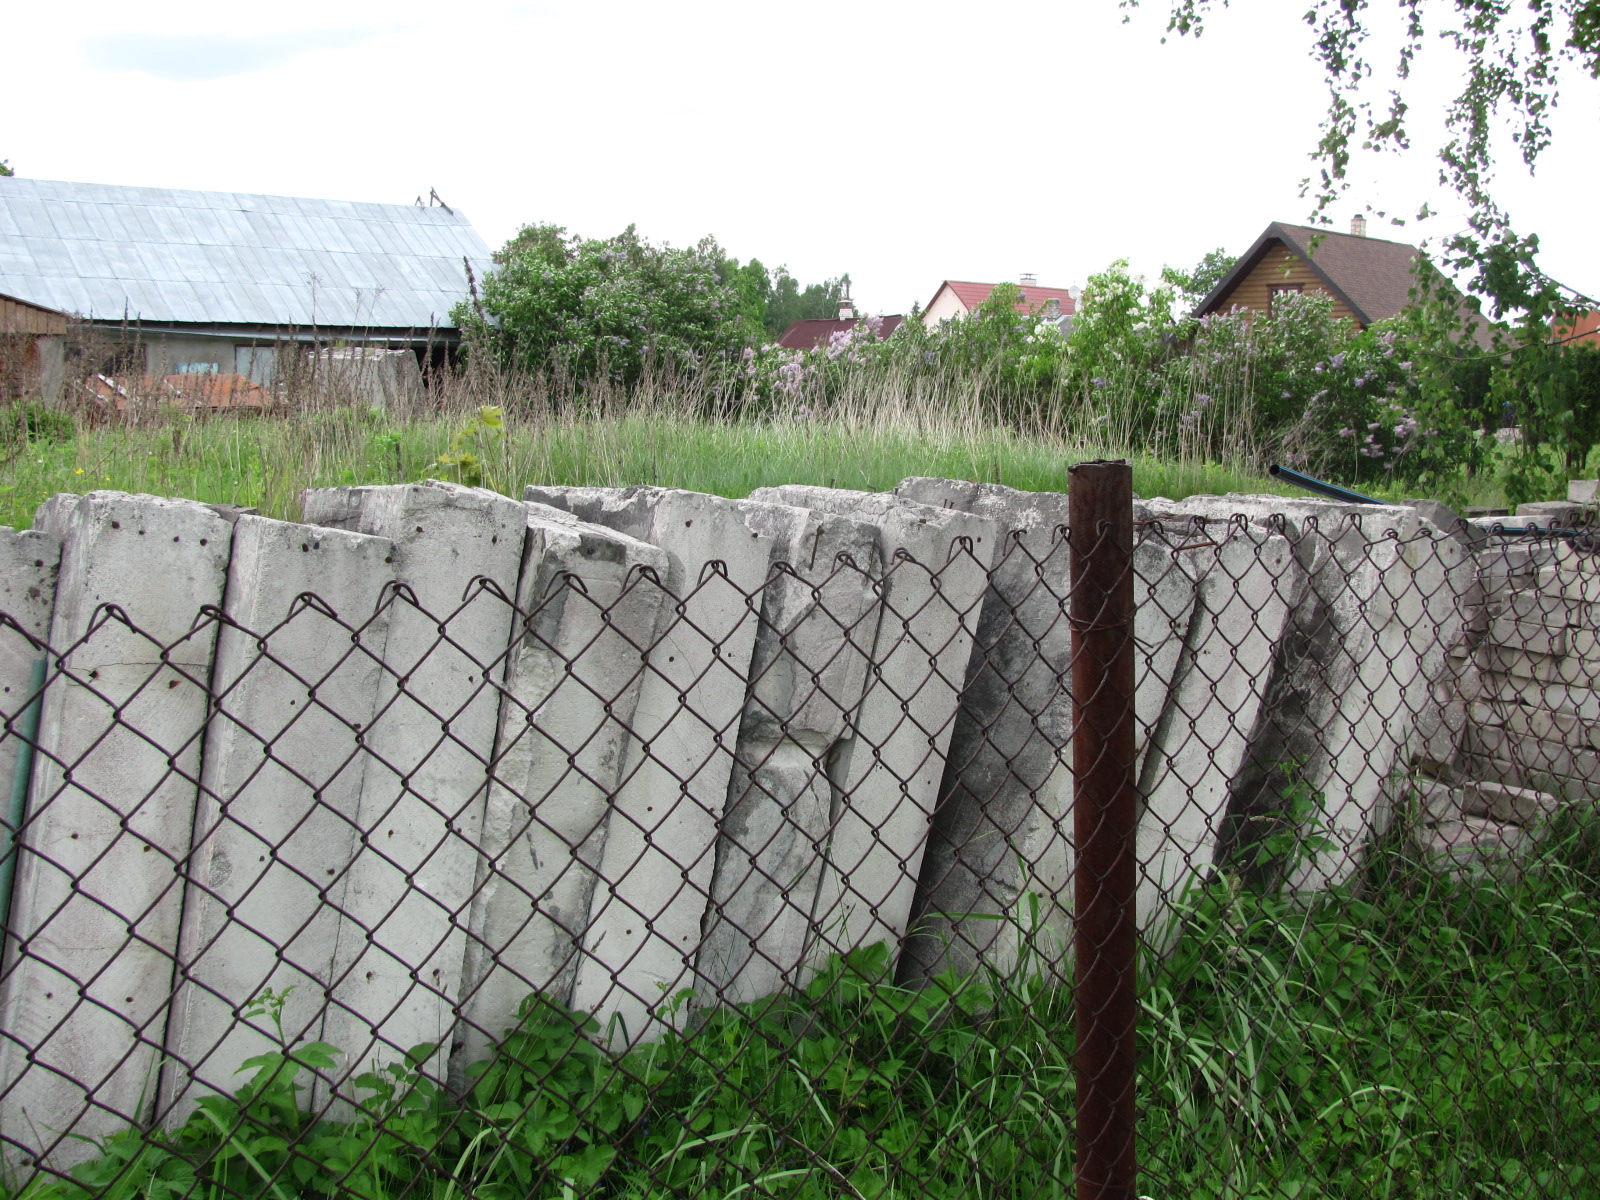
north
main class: Grassland
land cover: Grassland without tree/shrub cover
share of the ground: > 75 %
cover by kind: herbaceous plants 100 %
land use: Residential
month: June
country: LV
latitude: 56.8060
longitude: 23.9880
